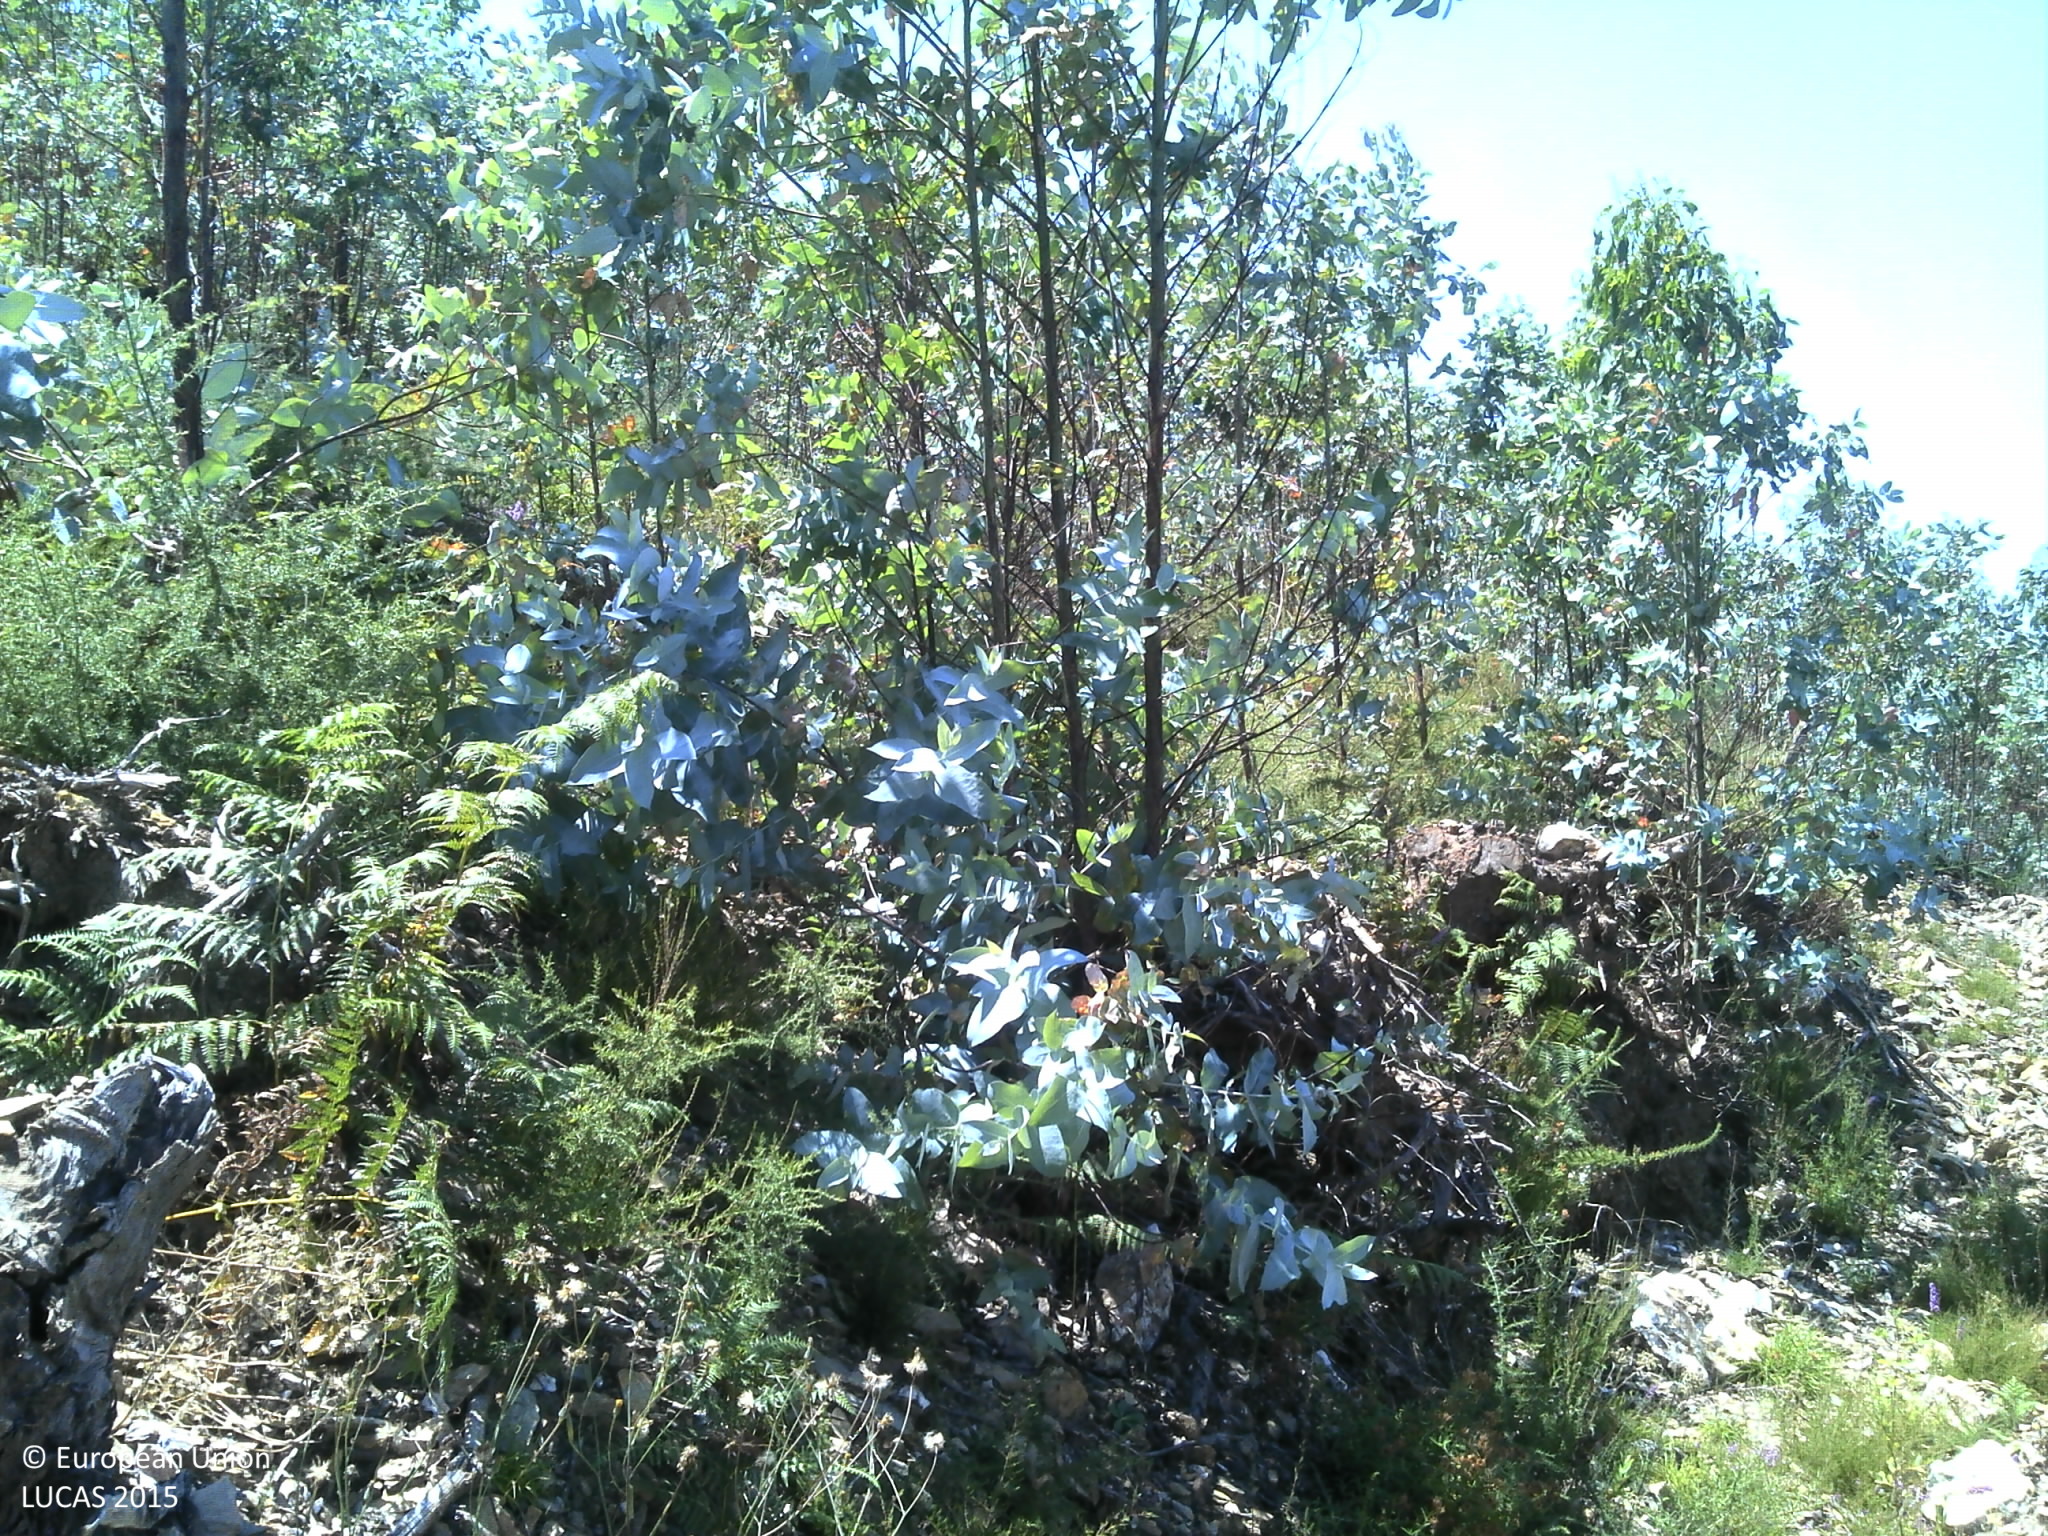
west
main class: Woodland
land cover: Broadleaved woodland
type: boreal forest
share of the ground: 25 - 50 %
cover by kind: unconsolidated bare surface 50 %, broadleaved forest trees 30 %, shrubs 20 %
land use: Forestry
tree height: < 5 m
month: July
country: PT
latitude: 40.6620
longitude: -8.3643
